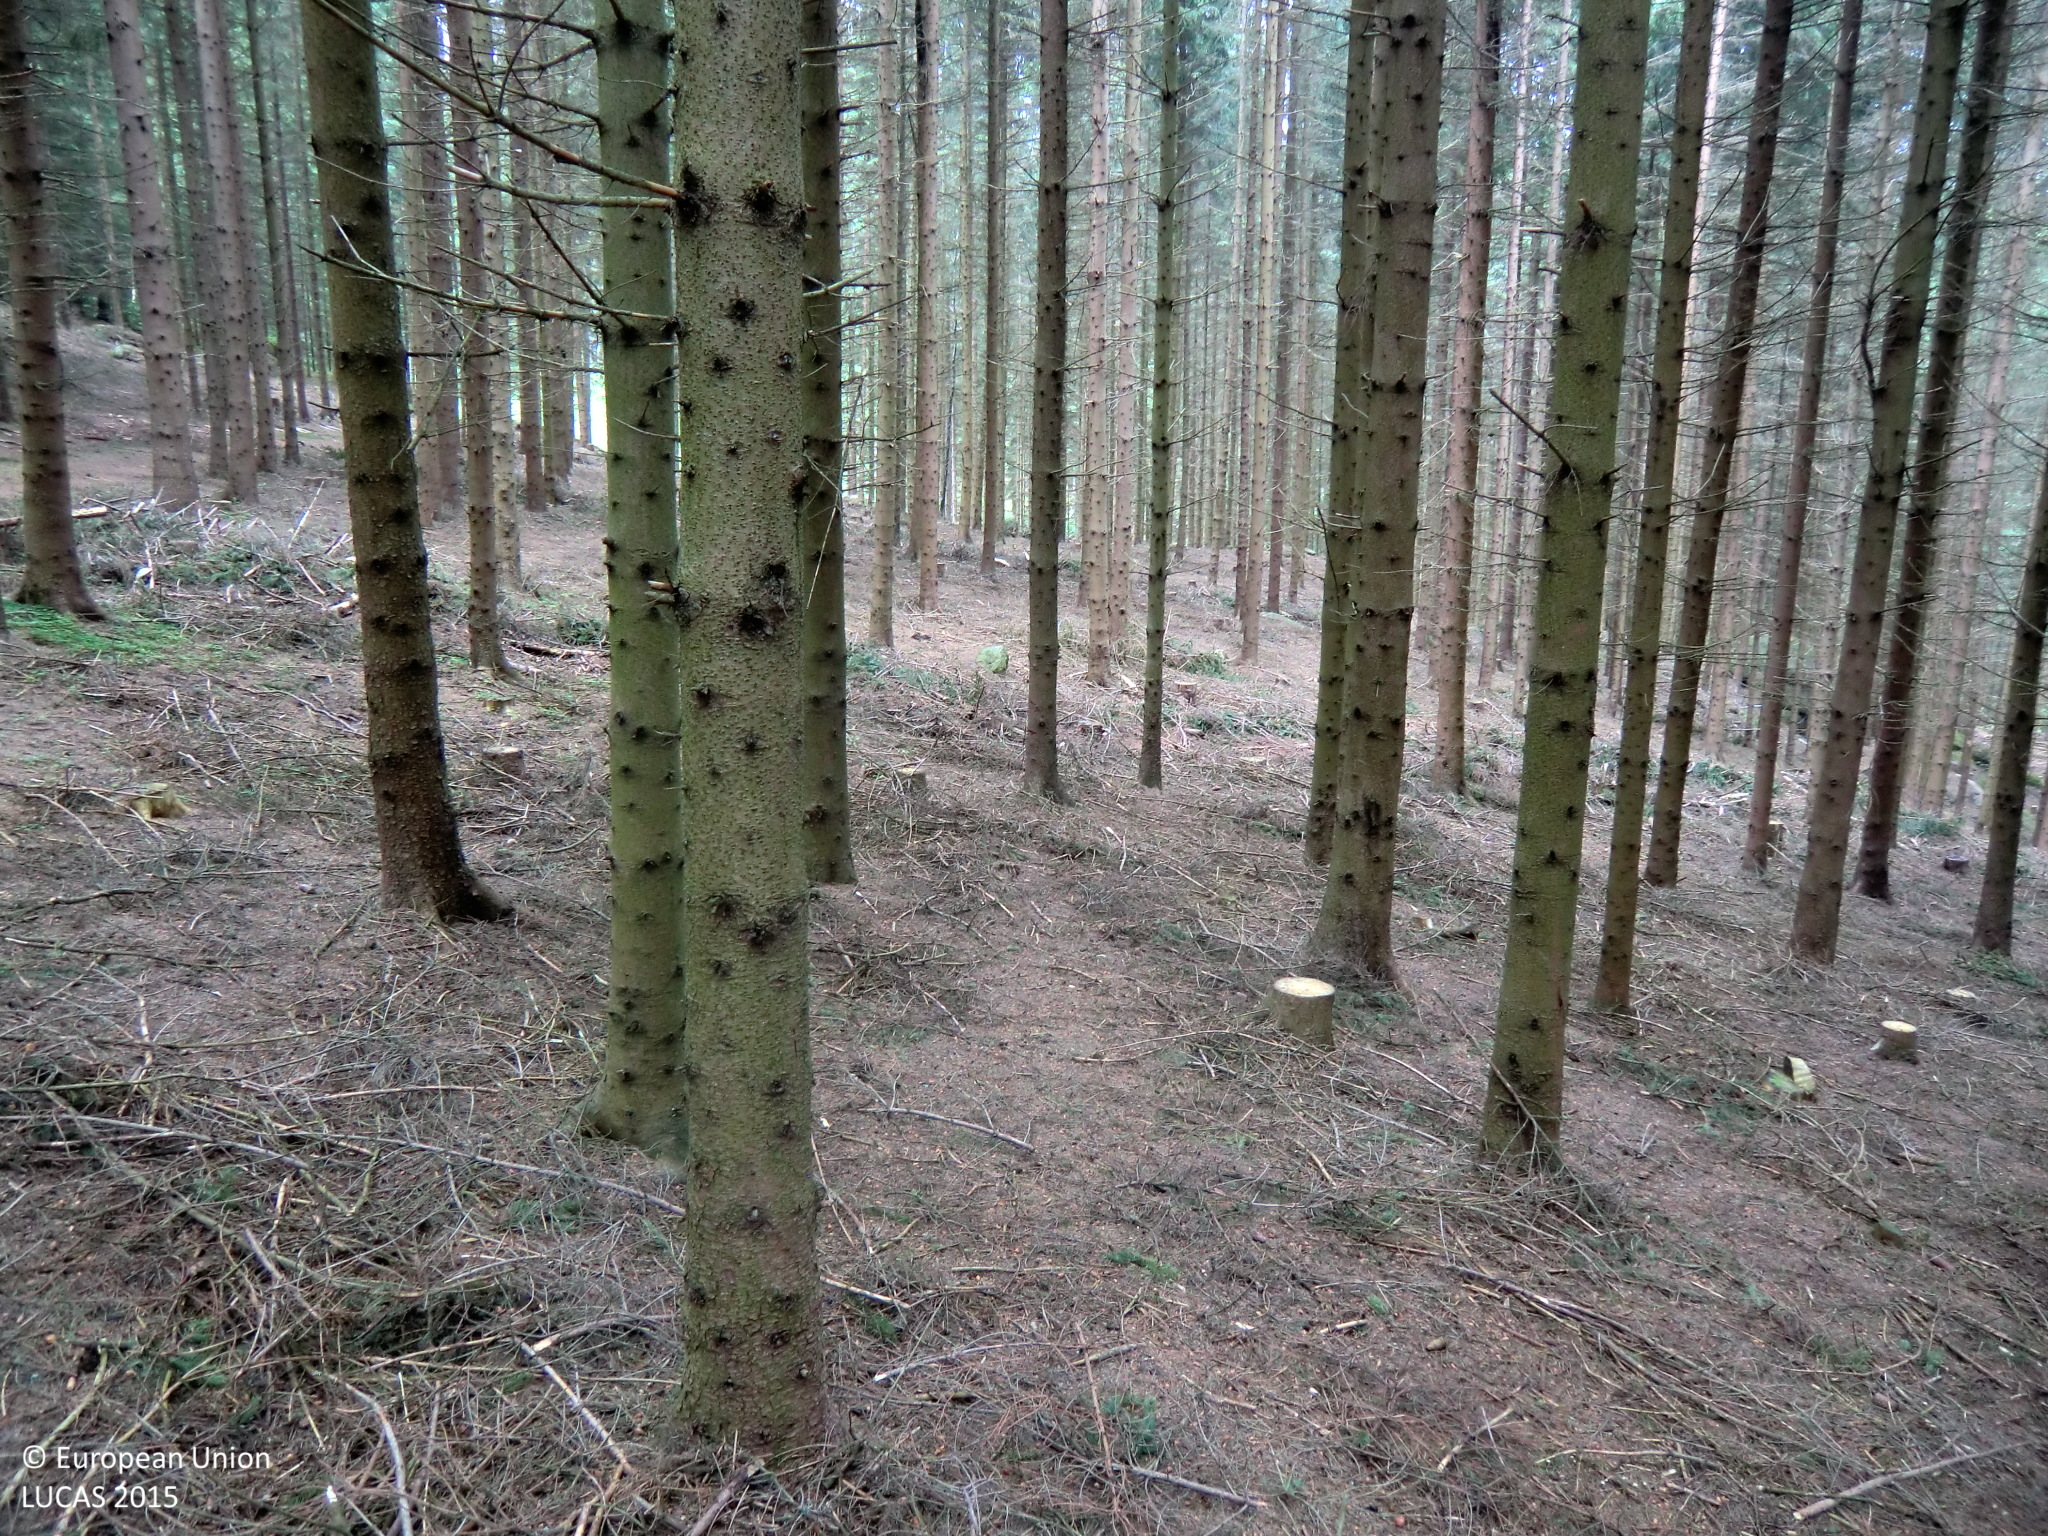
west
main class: Woodland
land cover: Spruce dominated coniferous woodland
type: hemiboreal forest and nemoral coniferous forest and mixed broadleaved-coniferous forest
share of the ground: > 75 %
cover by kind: coniferous forest trees 90 %, unconsolidated bare surface 10 %
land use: Forestry
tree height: > 5 m
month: June
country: AT
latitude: 48.6038
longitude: 14.8428
